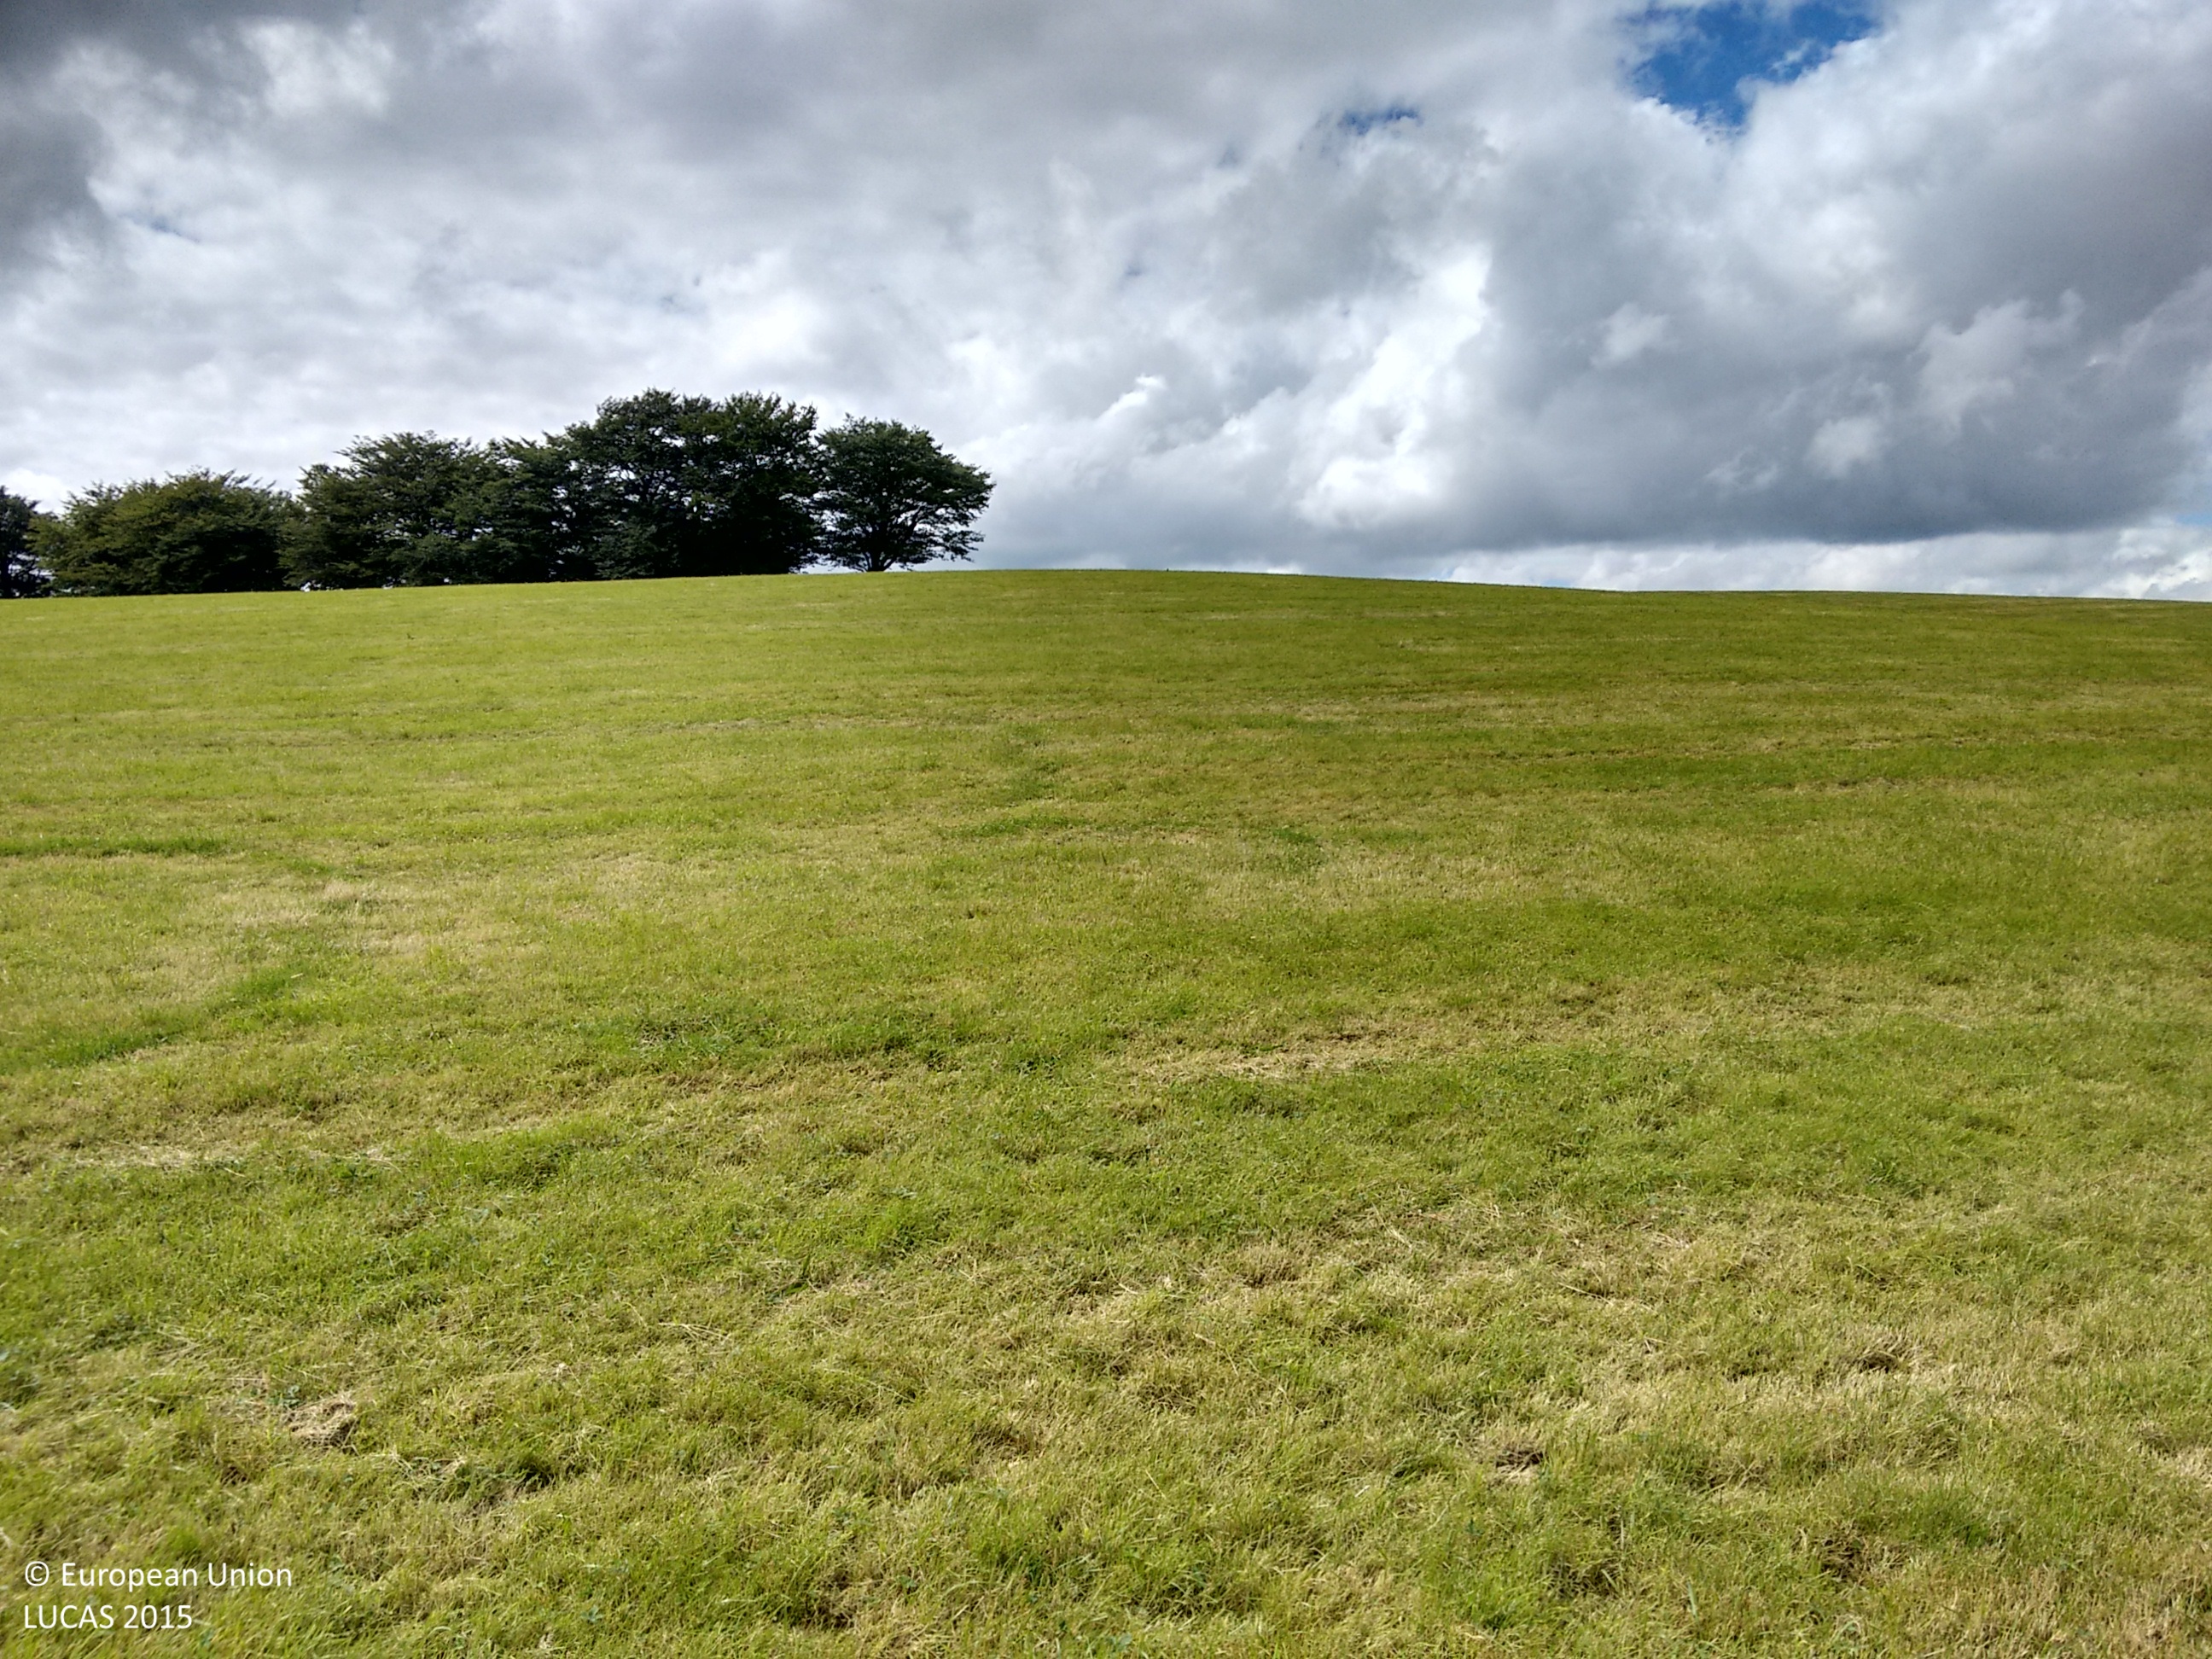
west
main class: Grassland
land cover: Grassland without tree/shrub cover
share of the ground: > 75 %
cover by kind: herbaceous plants 100 %
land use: Agriculture (excluding fallow land and kitchen gardens)
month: August
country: GB
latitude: 52.0055
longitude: -4.0961
